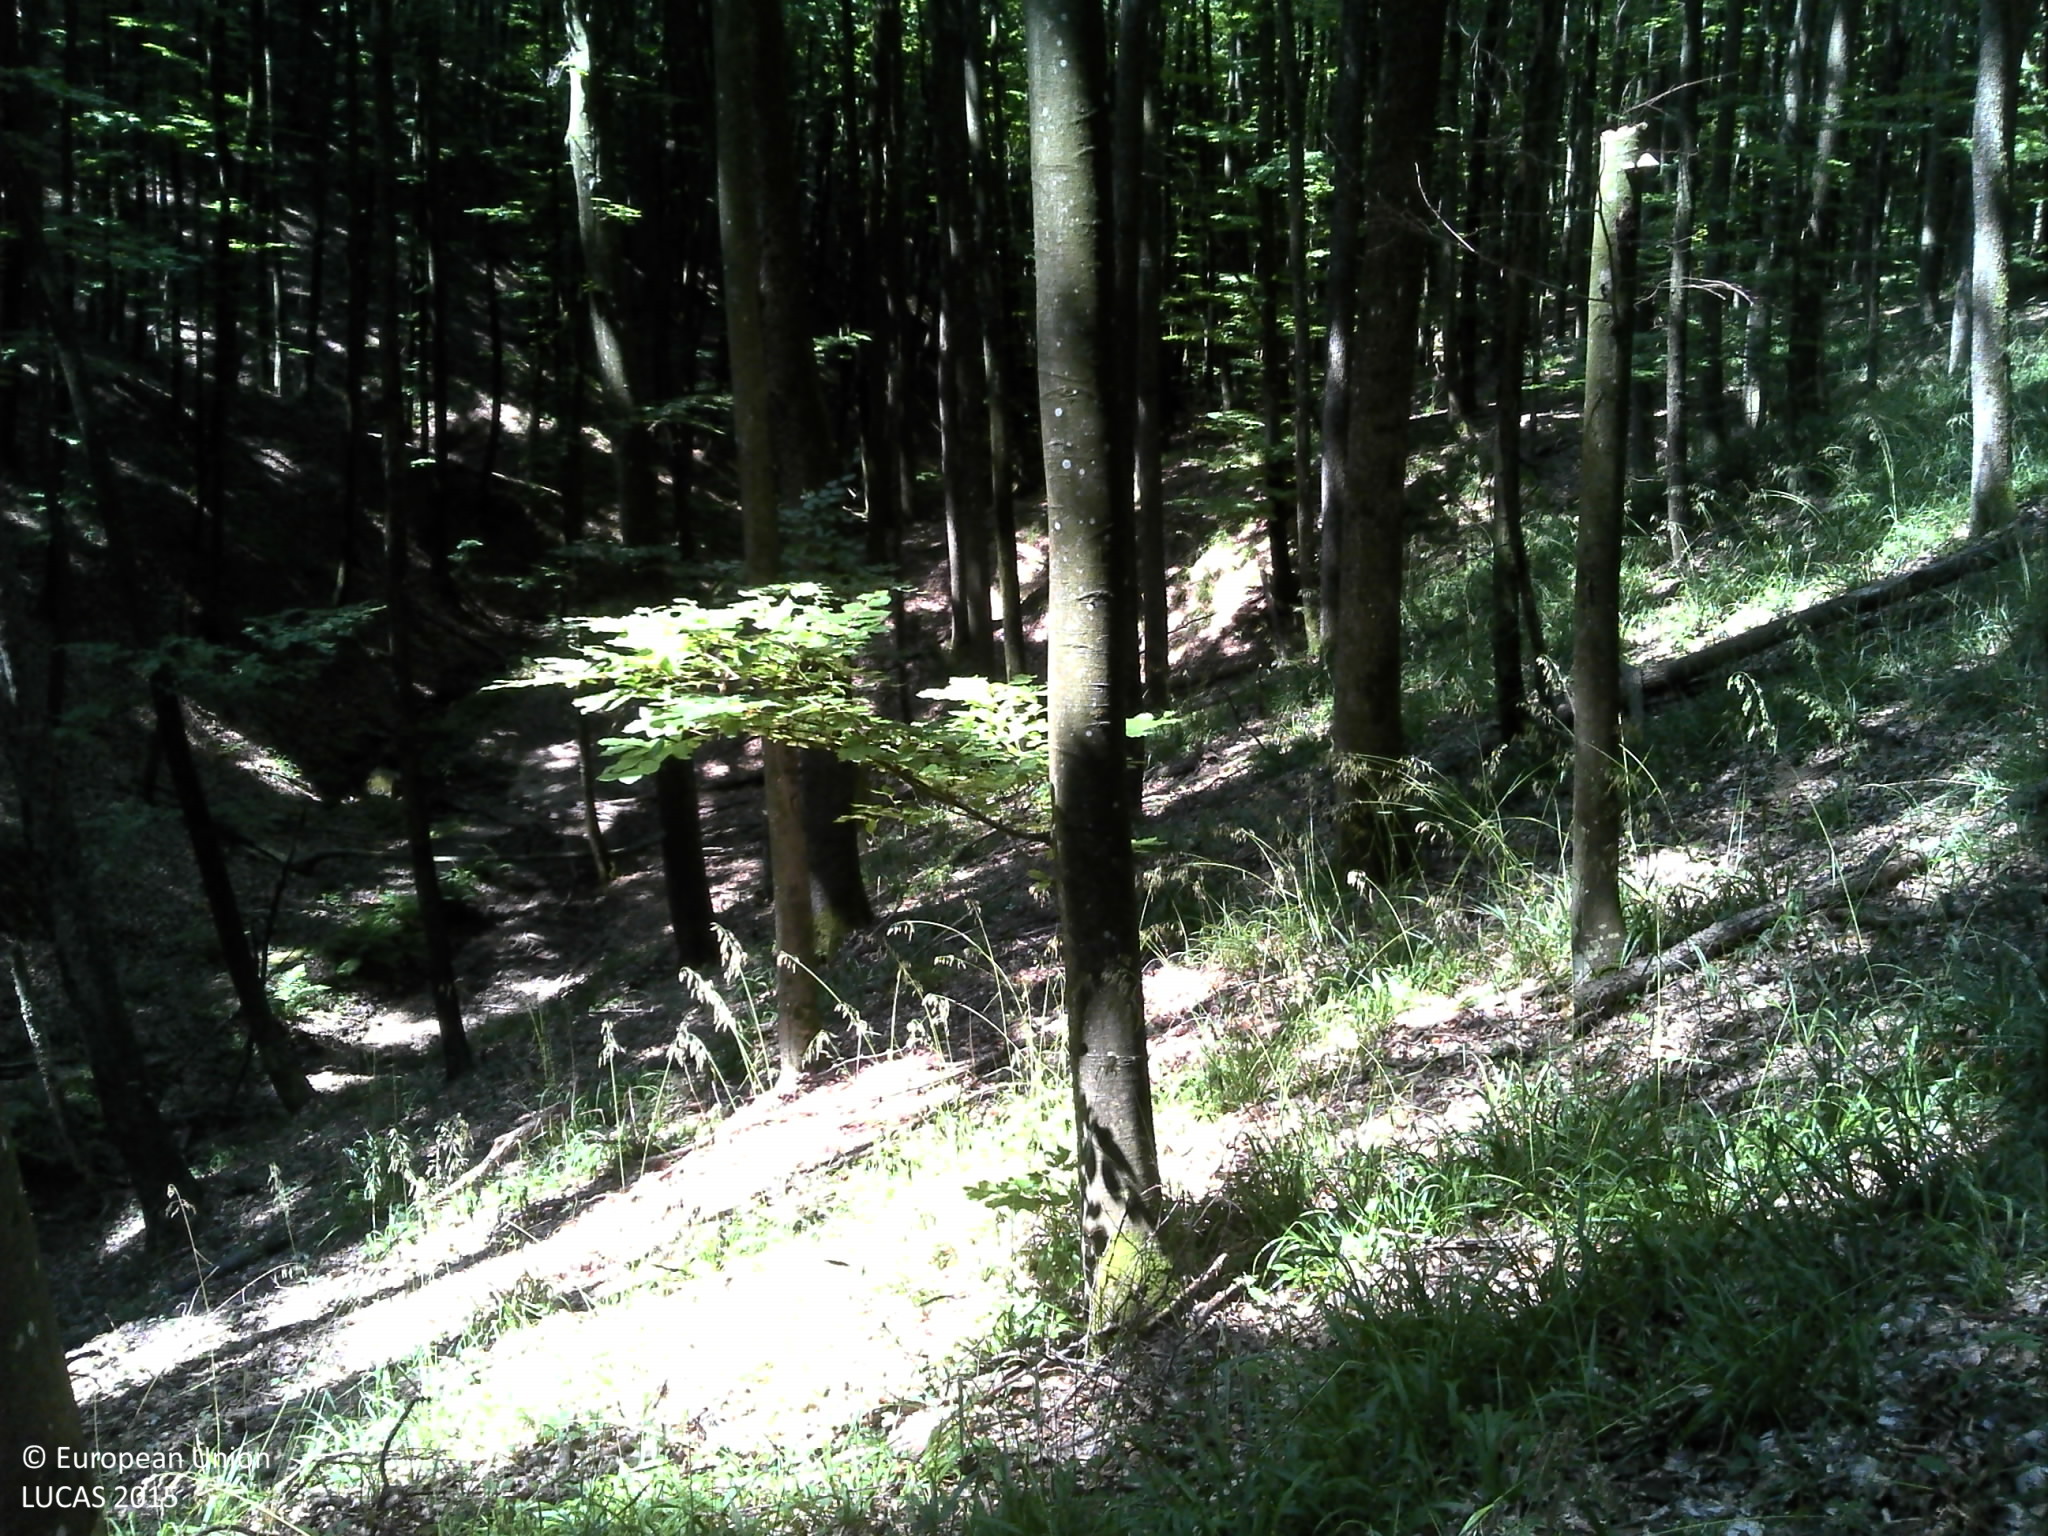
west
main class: Woodland
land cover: Broadleaved woodland
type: acidophilous oak and oak-birch forest
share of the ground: > 75 %
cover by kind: broadleaved forest trees 90 %, shrubs 5 %, herbaceous plants 5 %
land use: Forestry
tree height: > 5 m
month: July
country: HR
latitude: 45.6752
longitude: 16.6361
